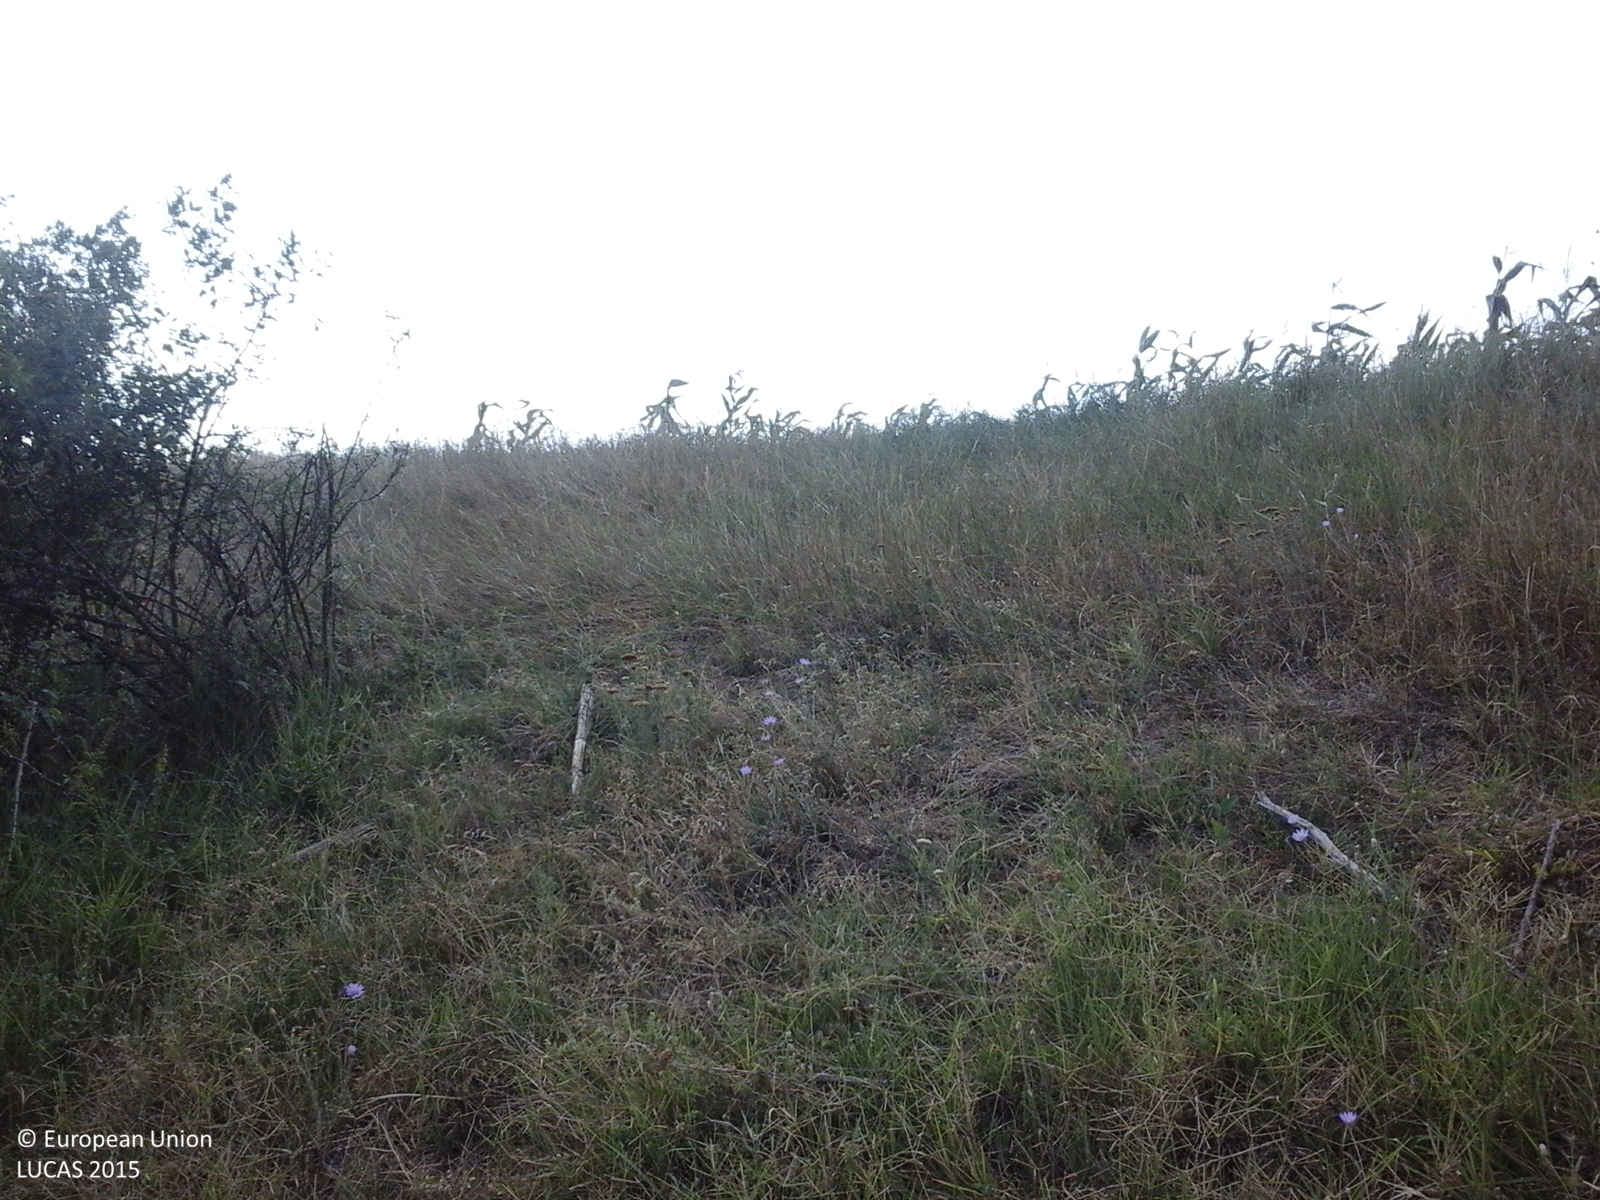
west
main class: Shrubland
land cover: Shrubland with sparse tree cover
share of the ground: > 75 %
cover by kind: herbaceous plants 60 %, shrubs 35 %, broadleaved forest trees 5 %
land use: Agriculture (excluding fallow land and kitchen gardens)
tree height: > 5 m
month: July
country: RO
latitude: 45.8821
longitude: 27.6467
